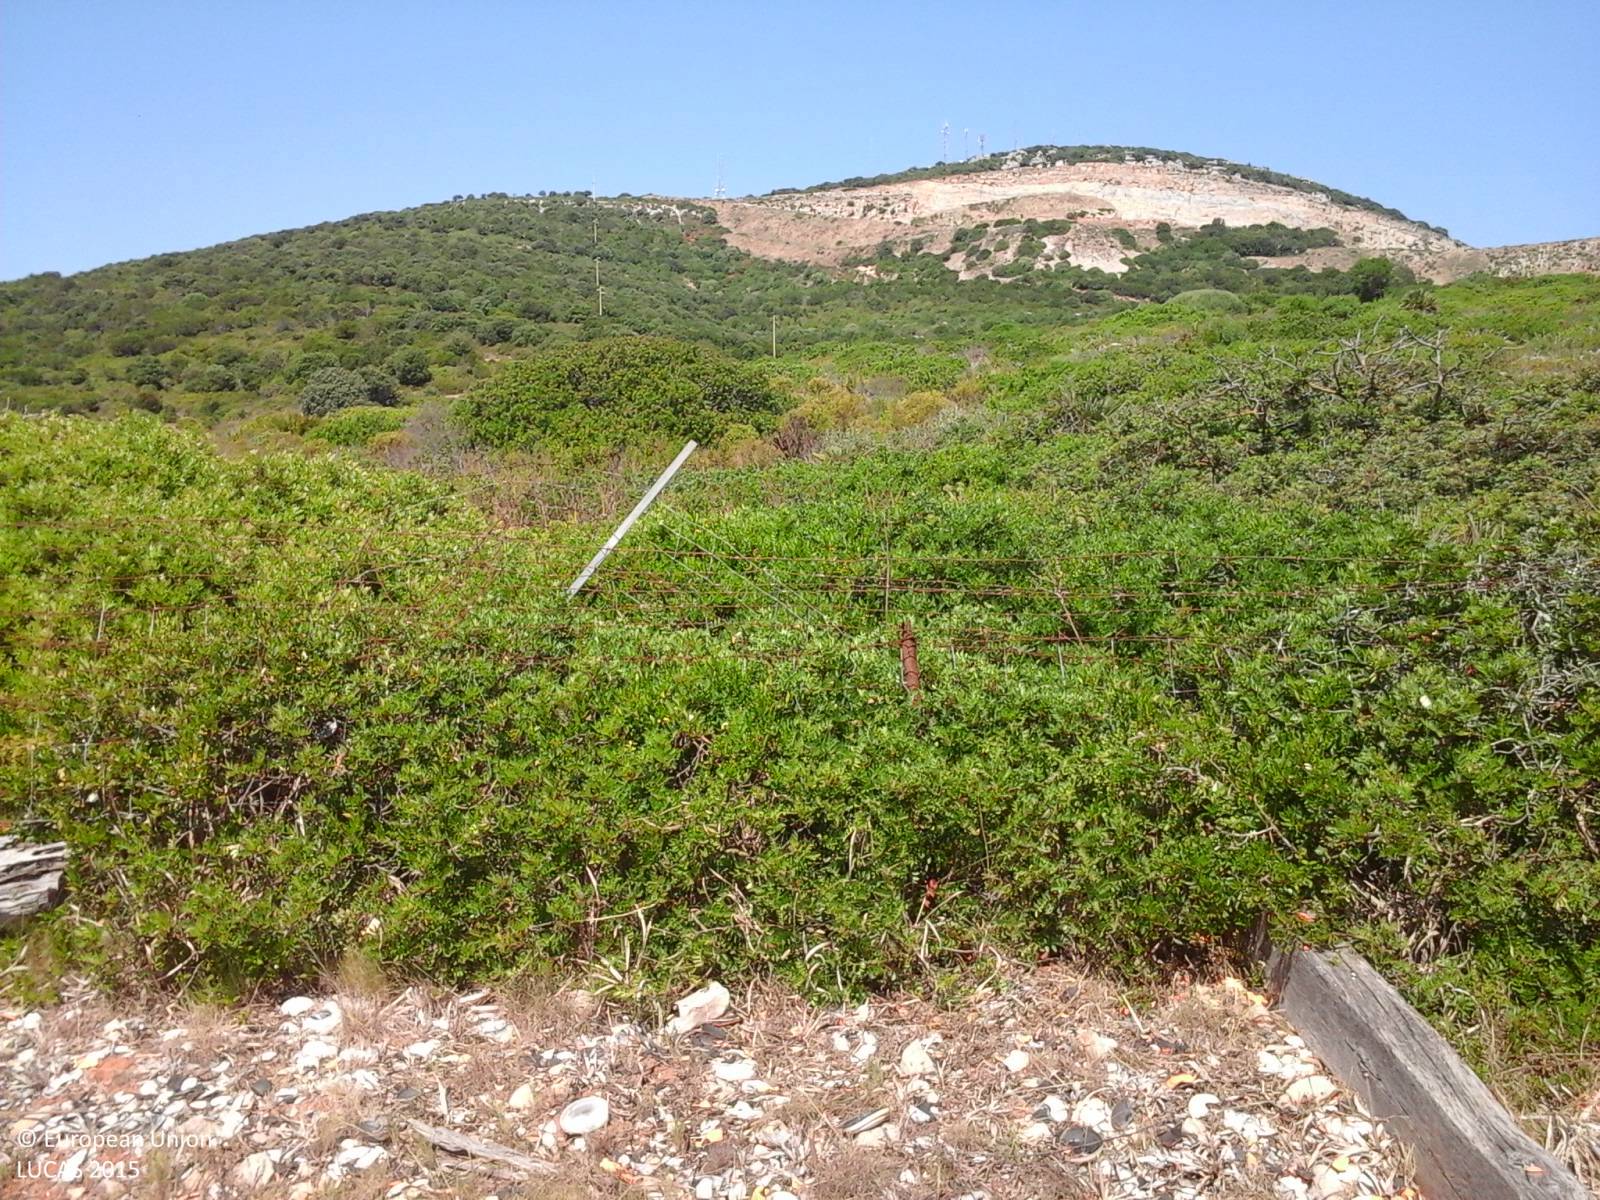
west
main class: Grassland
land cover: Spontaneously vegetated surfaces
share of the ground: > 75 %
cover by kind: herbaceous plants 95 %, shrubs 5 %
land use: Sport
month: June
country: IT
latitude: 40.7782
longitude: 8.3372
